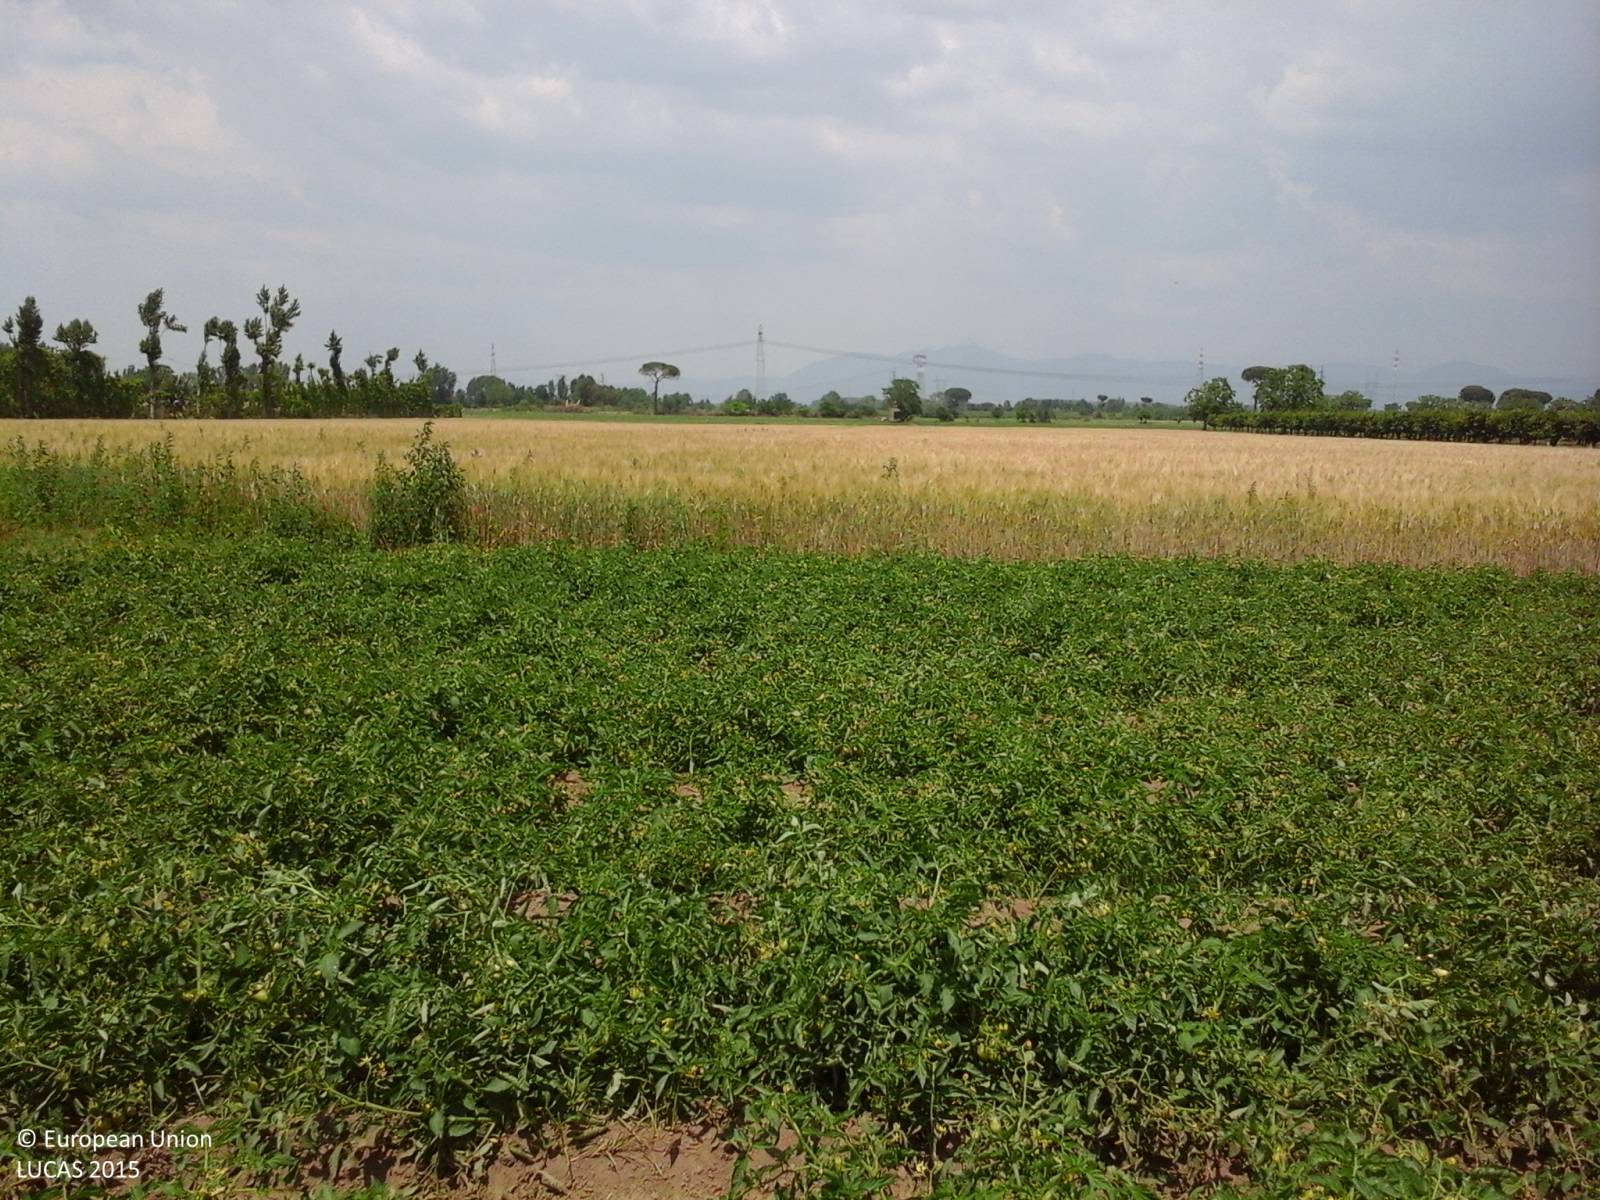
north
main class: Cropland
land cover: Tomatoes
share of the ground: > 75 %
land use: Agriculture (excluding fallow land and kitchen gardens)
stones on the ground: < 10 %
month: June
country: IT
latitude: 41.0296
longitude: 14.1816
